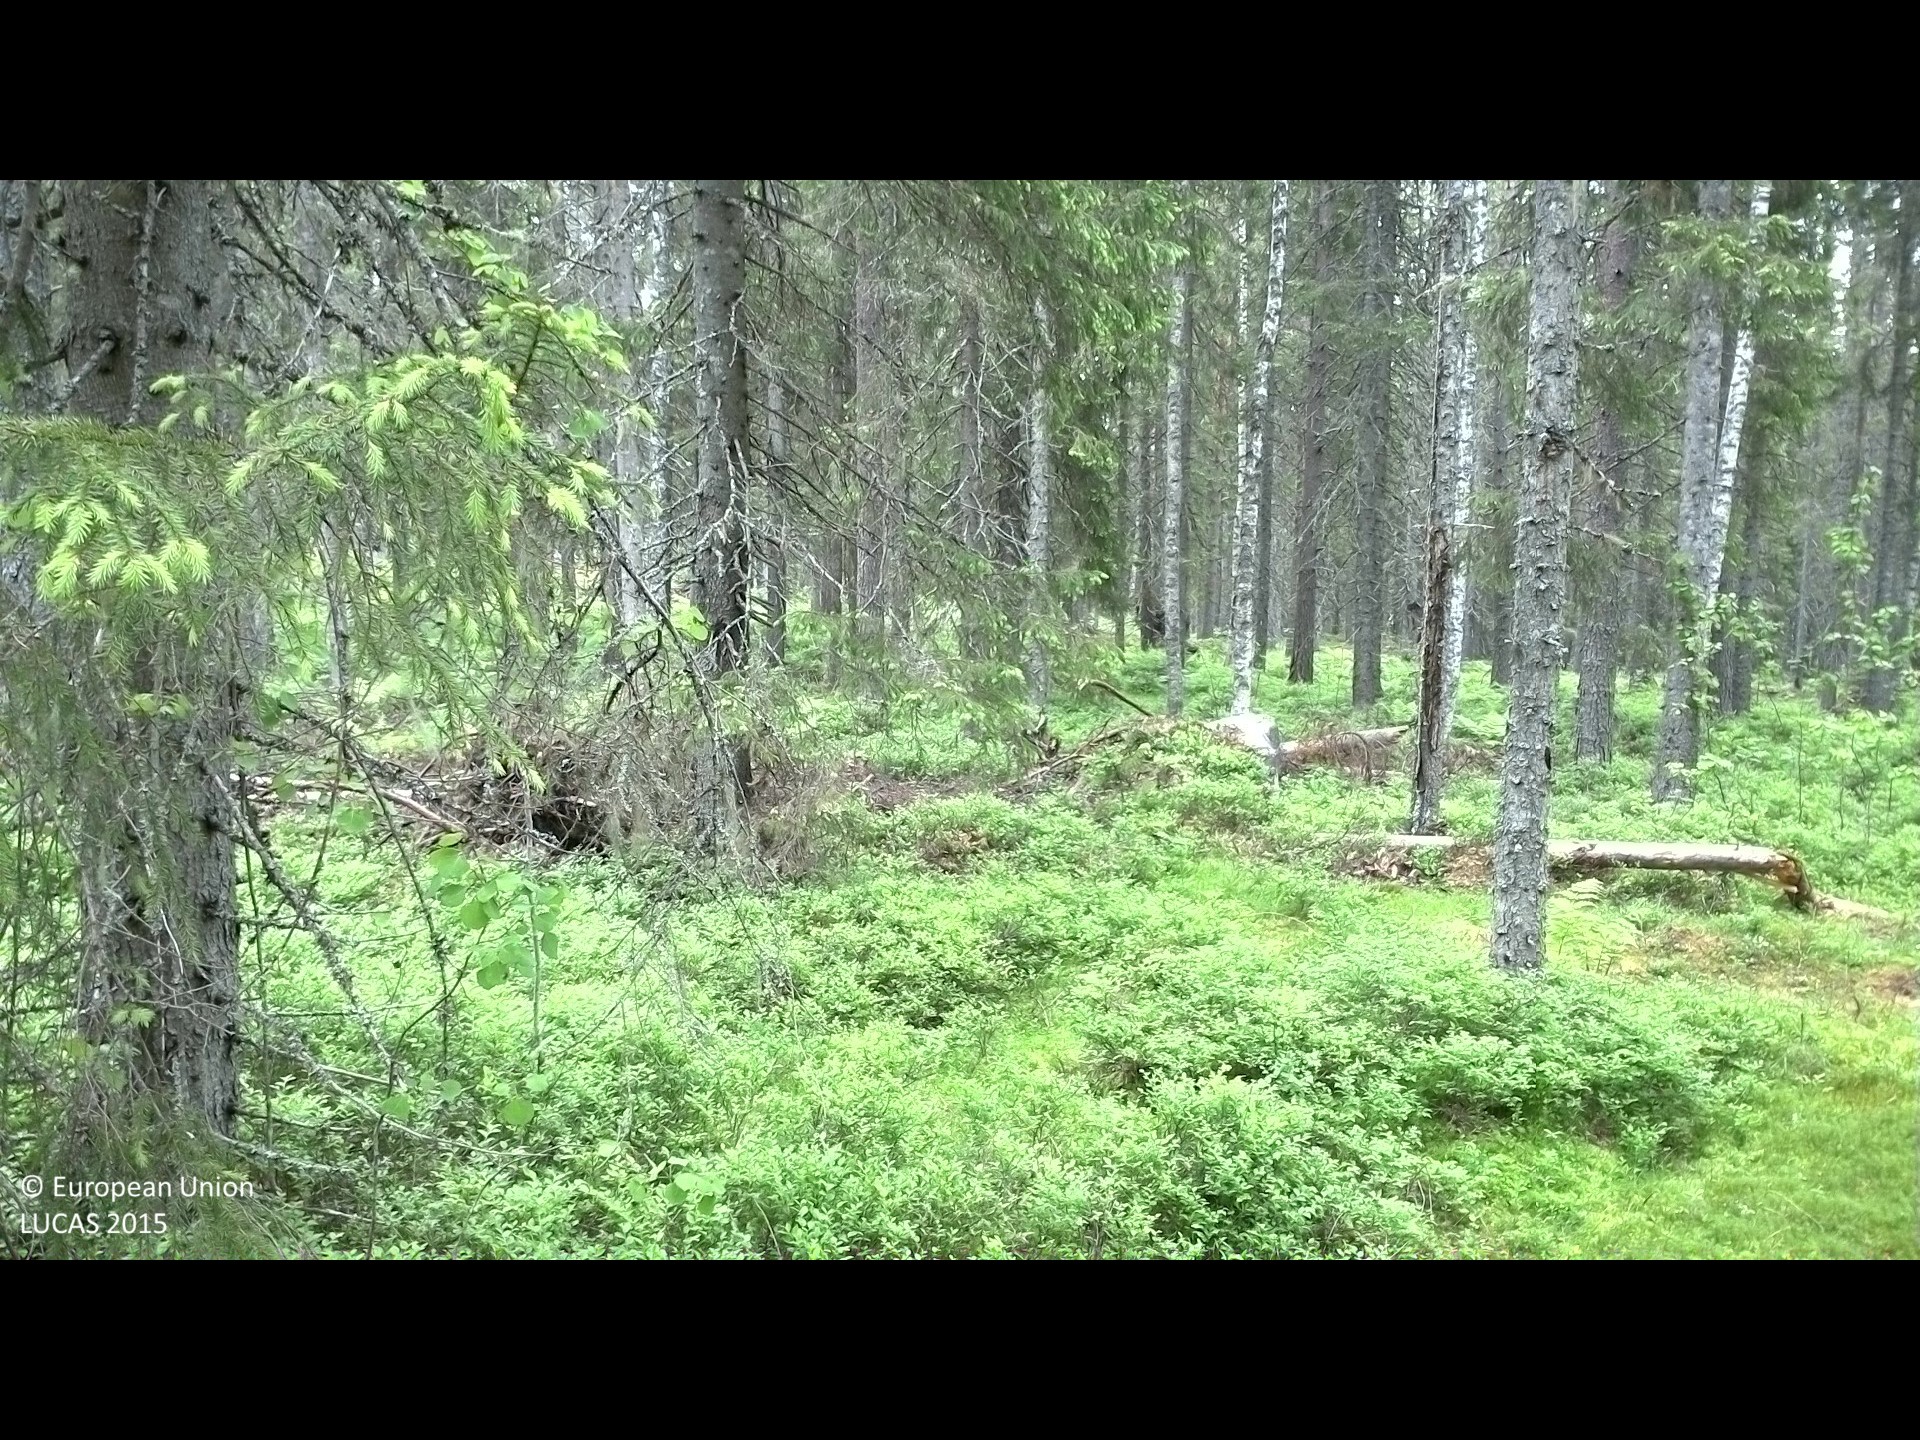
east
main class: Woodland
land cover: Spruce dominated coniferous woodland
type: boreal forest
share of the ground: 25 - 50 %
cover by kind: shrubs 40 %, coniferous forest trees 35 %, herbaceous plants 15 %, broadleaved forest trees 5 %, lichens and mosses 5 %
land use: Forestry
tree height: > 5 m
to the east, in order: Spruce dominated coniferous woodland; Tracks; Spruce dominated coniferous woodland; Tracks; Spruce dominated coniferous woodland; Other mixed woodland; Grassland without tree/shrub cover; Inland fresh water bodies
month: June
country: SE
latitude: 61.9472
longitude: 16.9014
